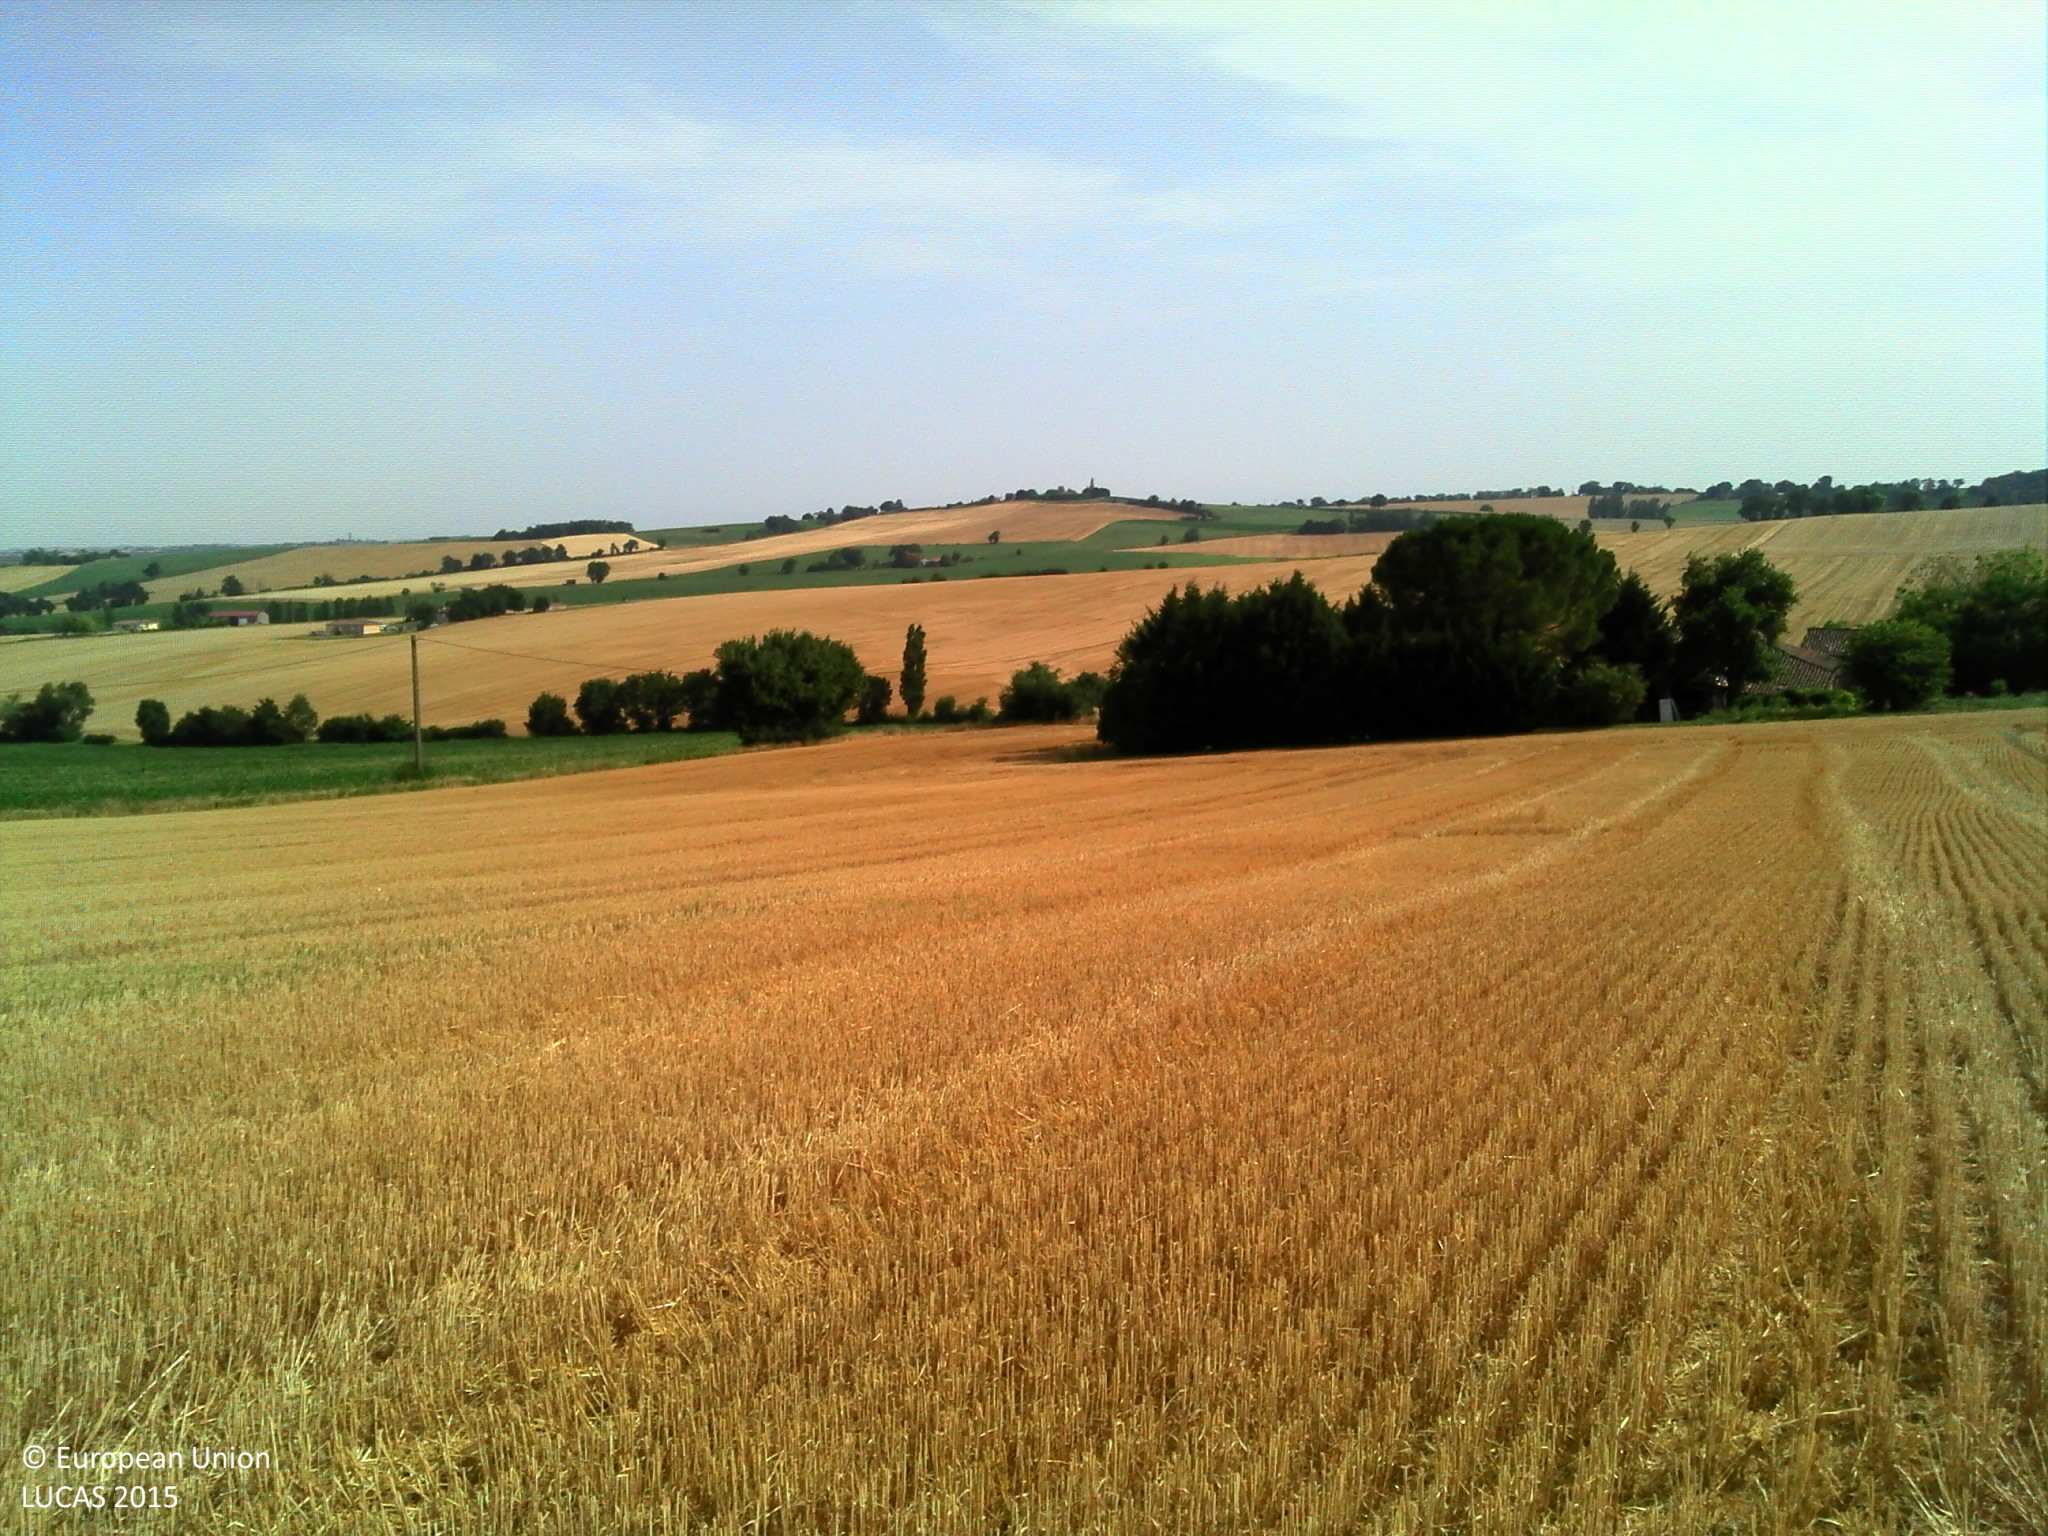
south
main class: Cropland
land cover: Durum wheat
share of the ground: > 75 %
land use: Agriculture (excluding fallow land and kitchen gardens)
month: July
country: FR
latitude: 43.5755
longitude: 0.9732
